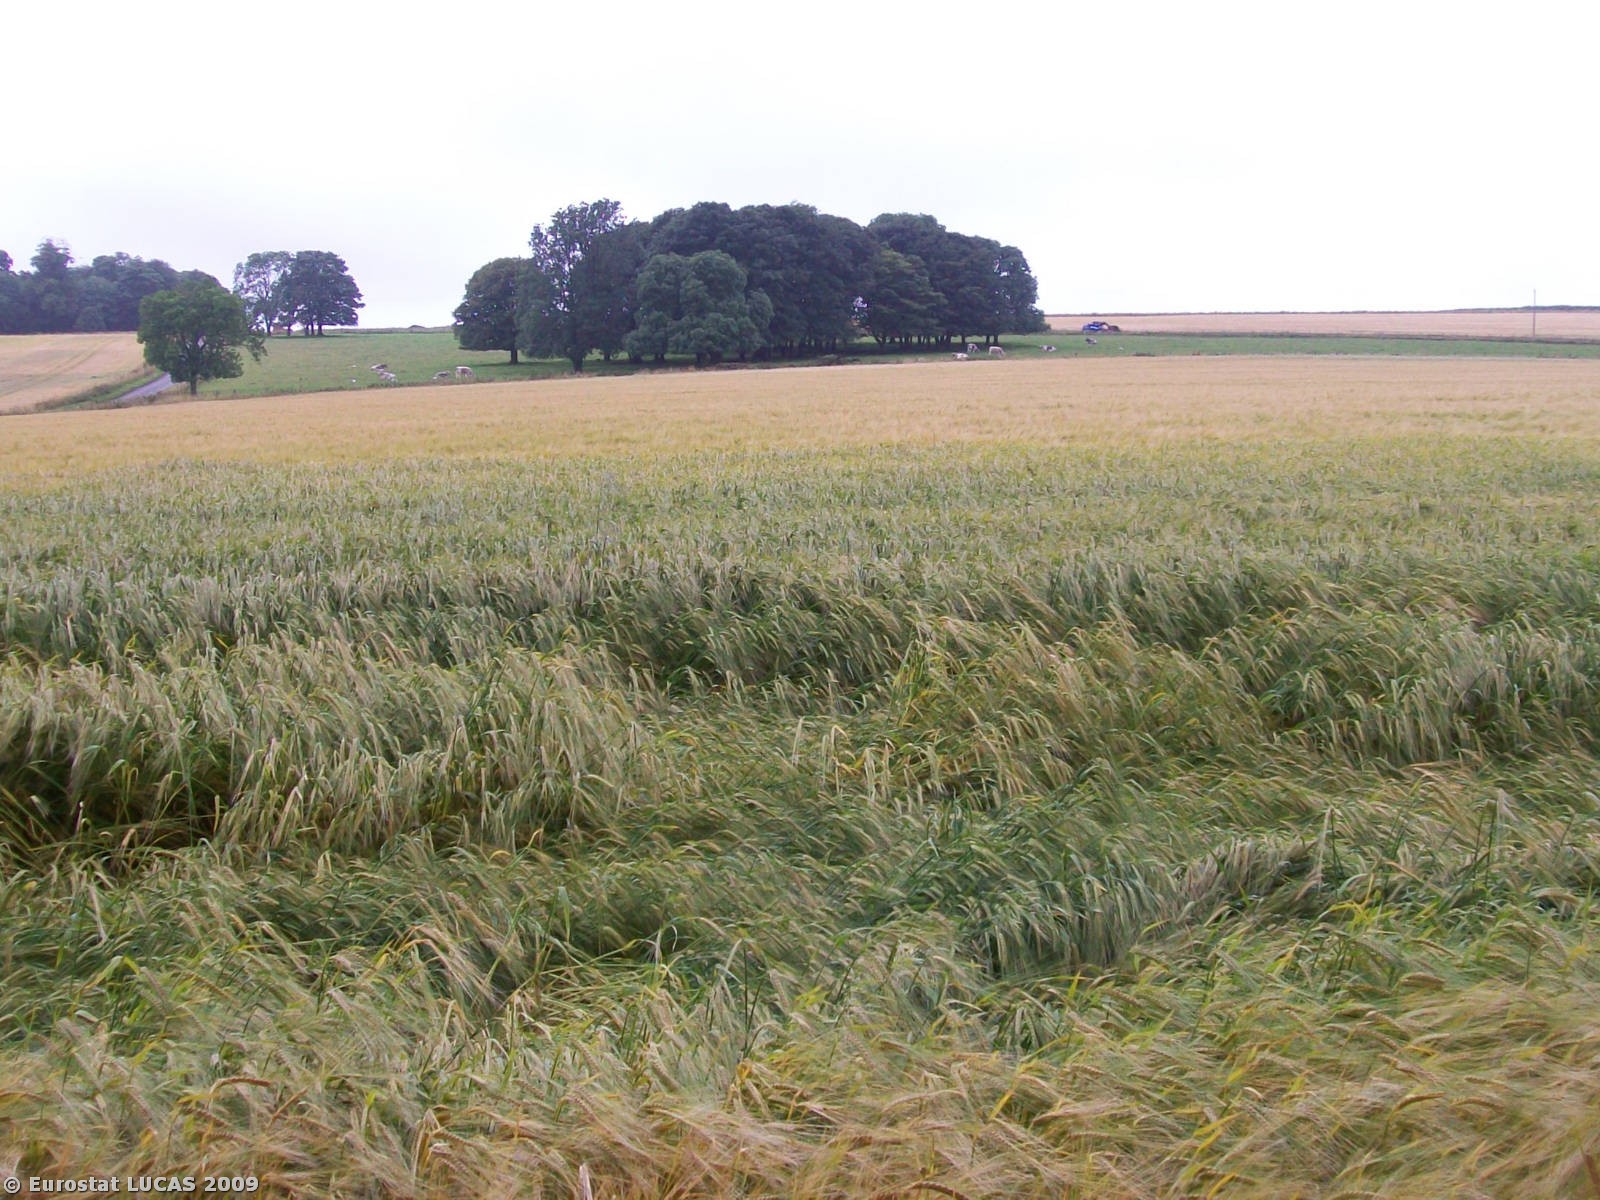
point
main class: Cropland
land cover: Barley
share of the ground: > 75 %
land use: Agriculture (excluding fallow land and kitchen gardens)
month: July
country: GB
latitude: 50.7048
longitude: -2.5703
